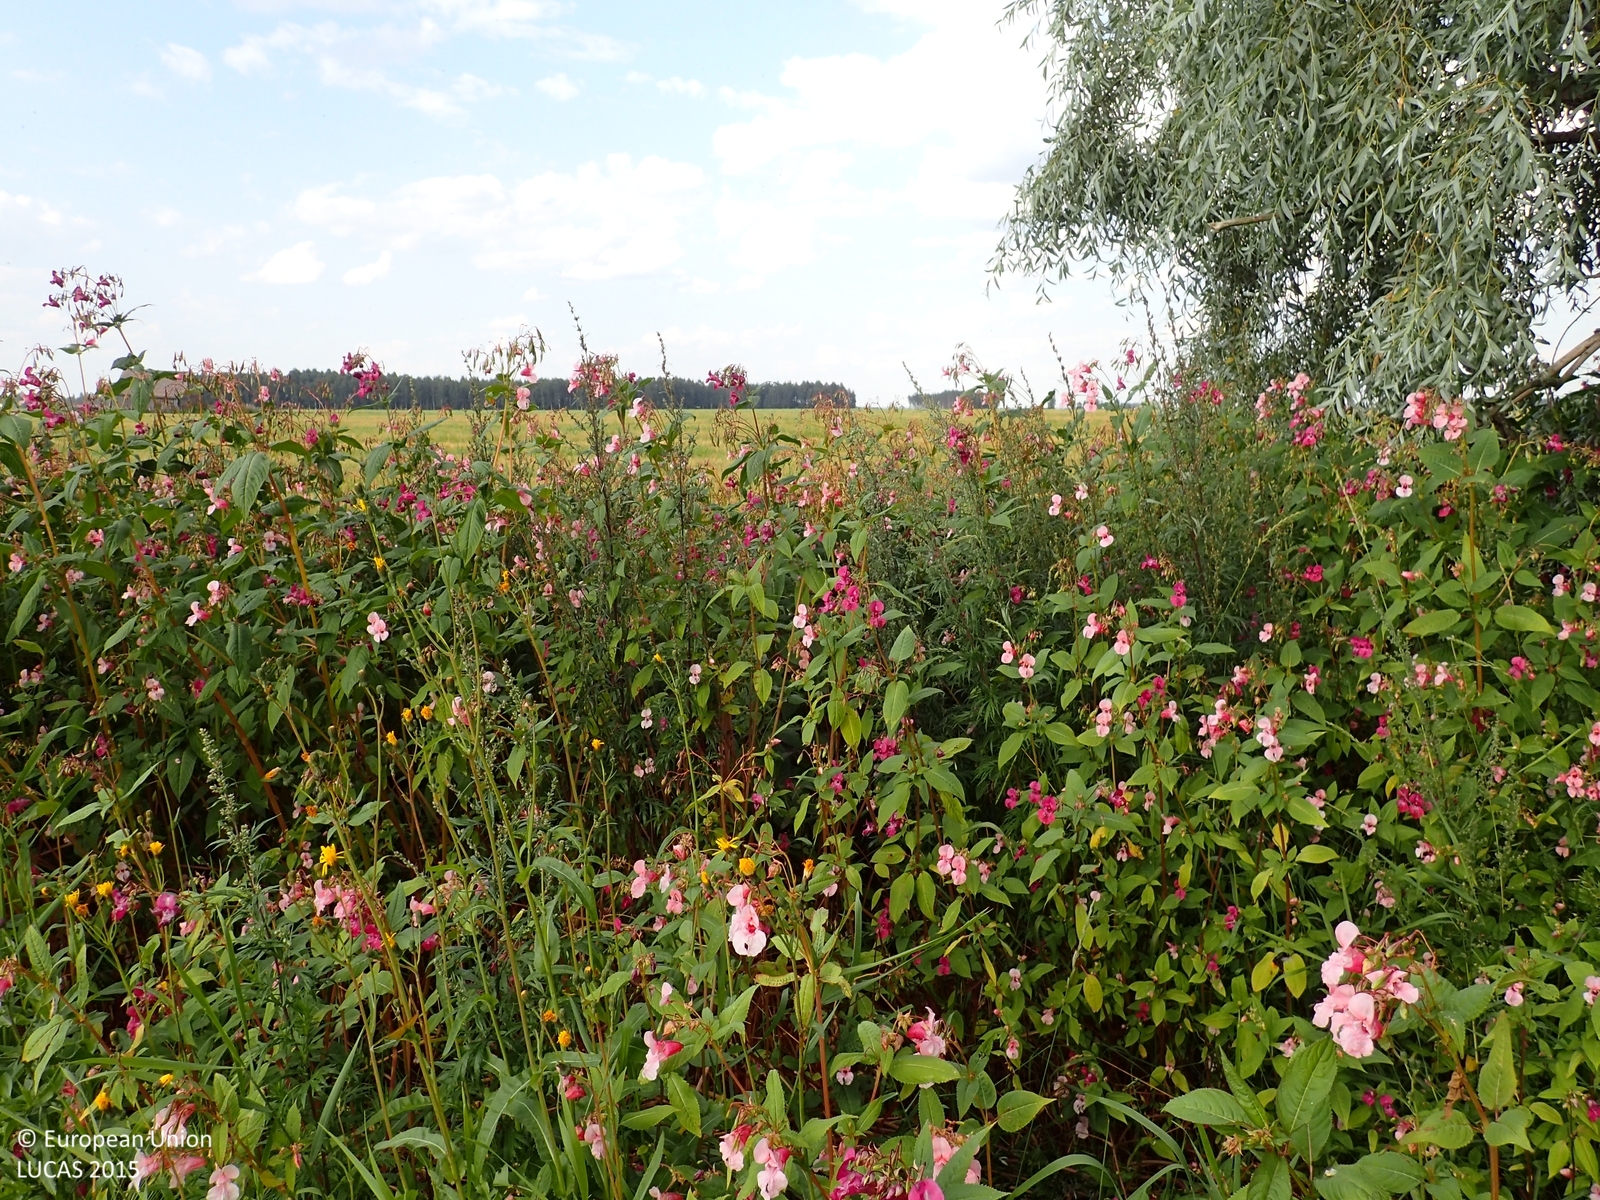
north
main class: Woodland
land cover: Pine dominated mixed woodland
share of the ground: > 75 %
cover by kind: broadleaved forest trees 60 %, coniferous forest trees 30 %, herbaceous plants 10 %
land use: Residential
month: August
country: FI
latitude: 62.7396
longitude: 22.5993
